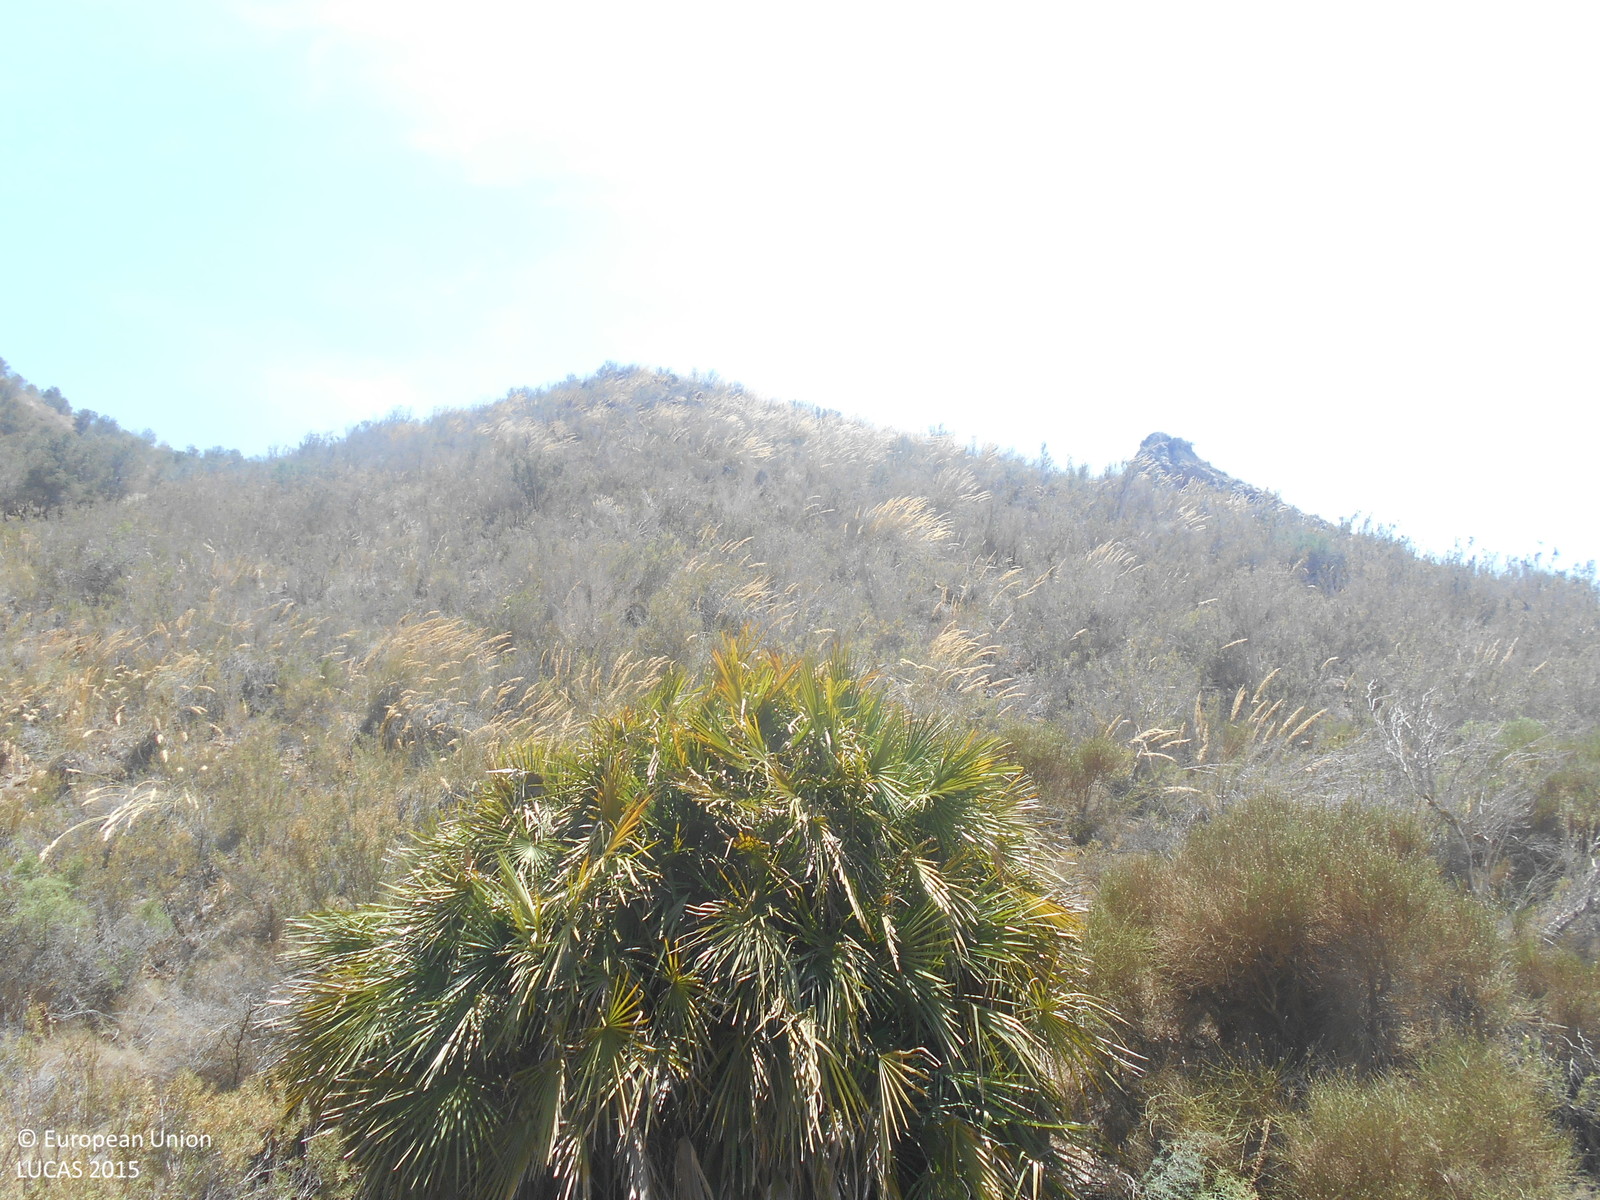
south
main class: Shrubland
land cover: Shrubland without tree cover
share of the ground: > 75 %
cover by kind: shrubs 90 %, unconsolidated bare surface 10 %
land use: Semi-natural and natural areas not in use
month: May
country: ES
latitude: 37.6387
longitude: -1.3014
